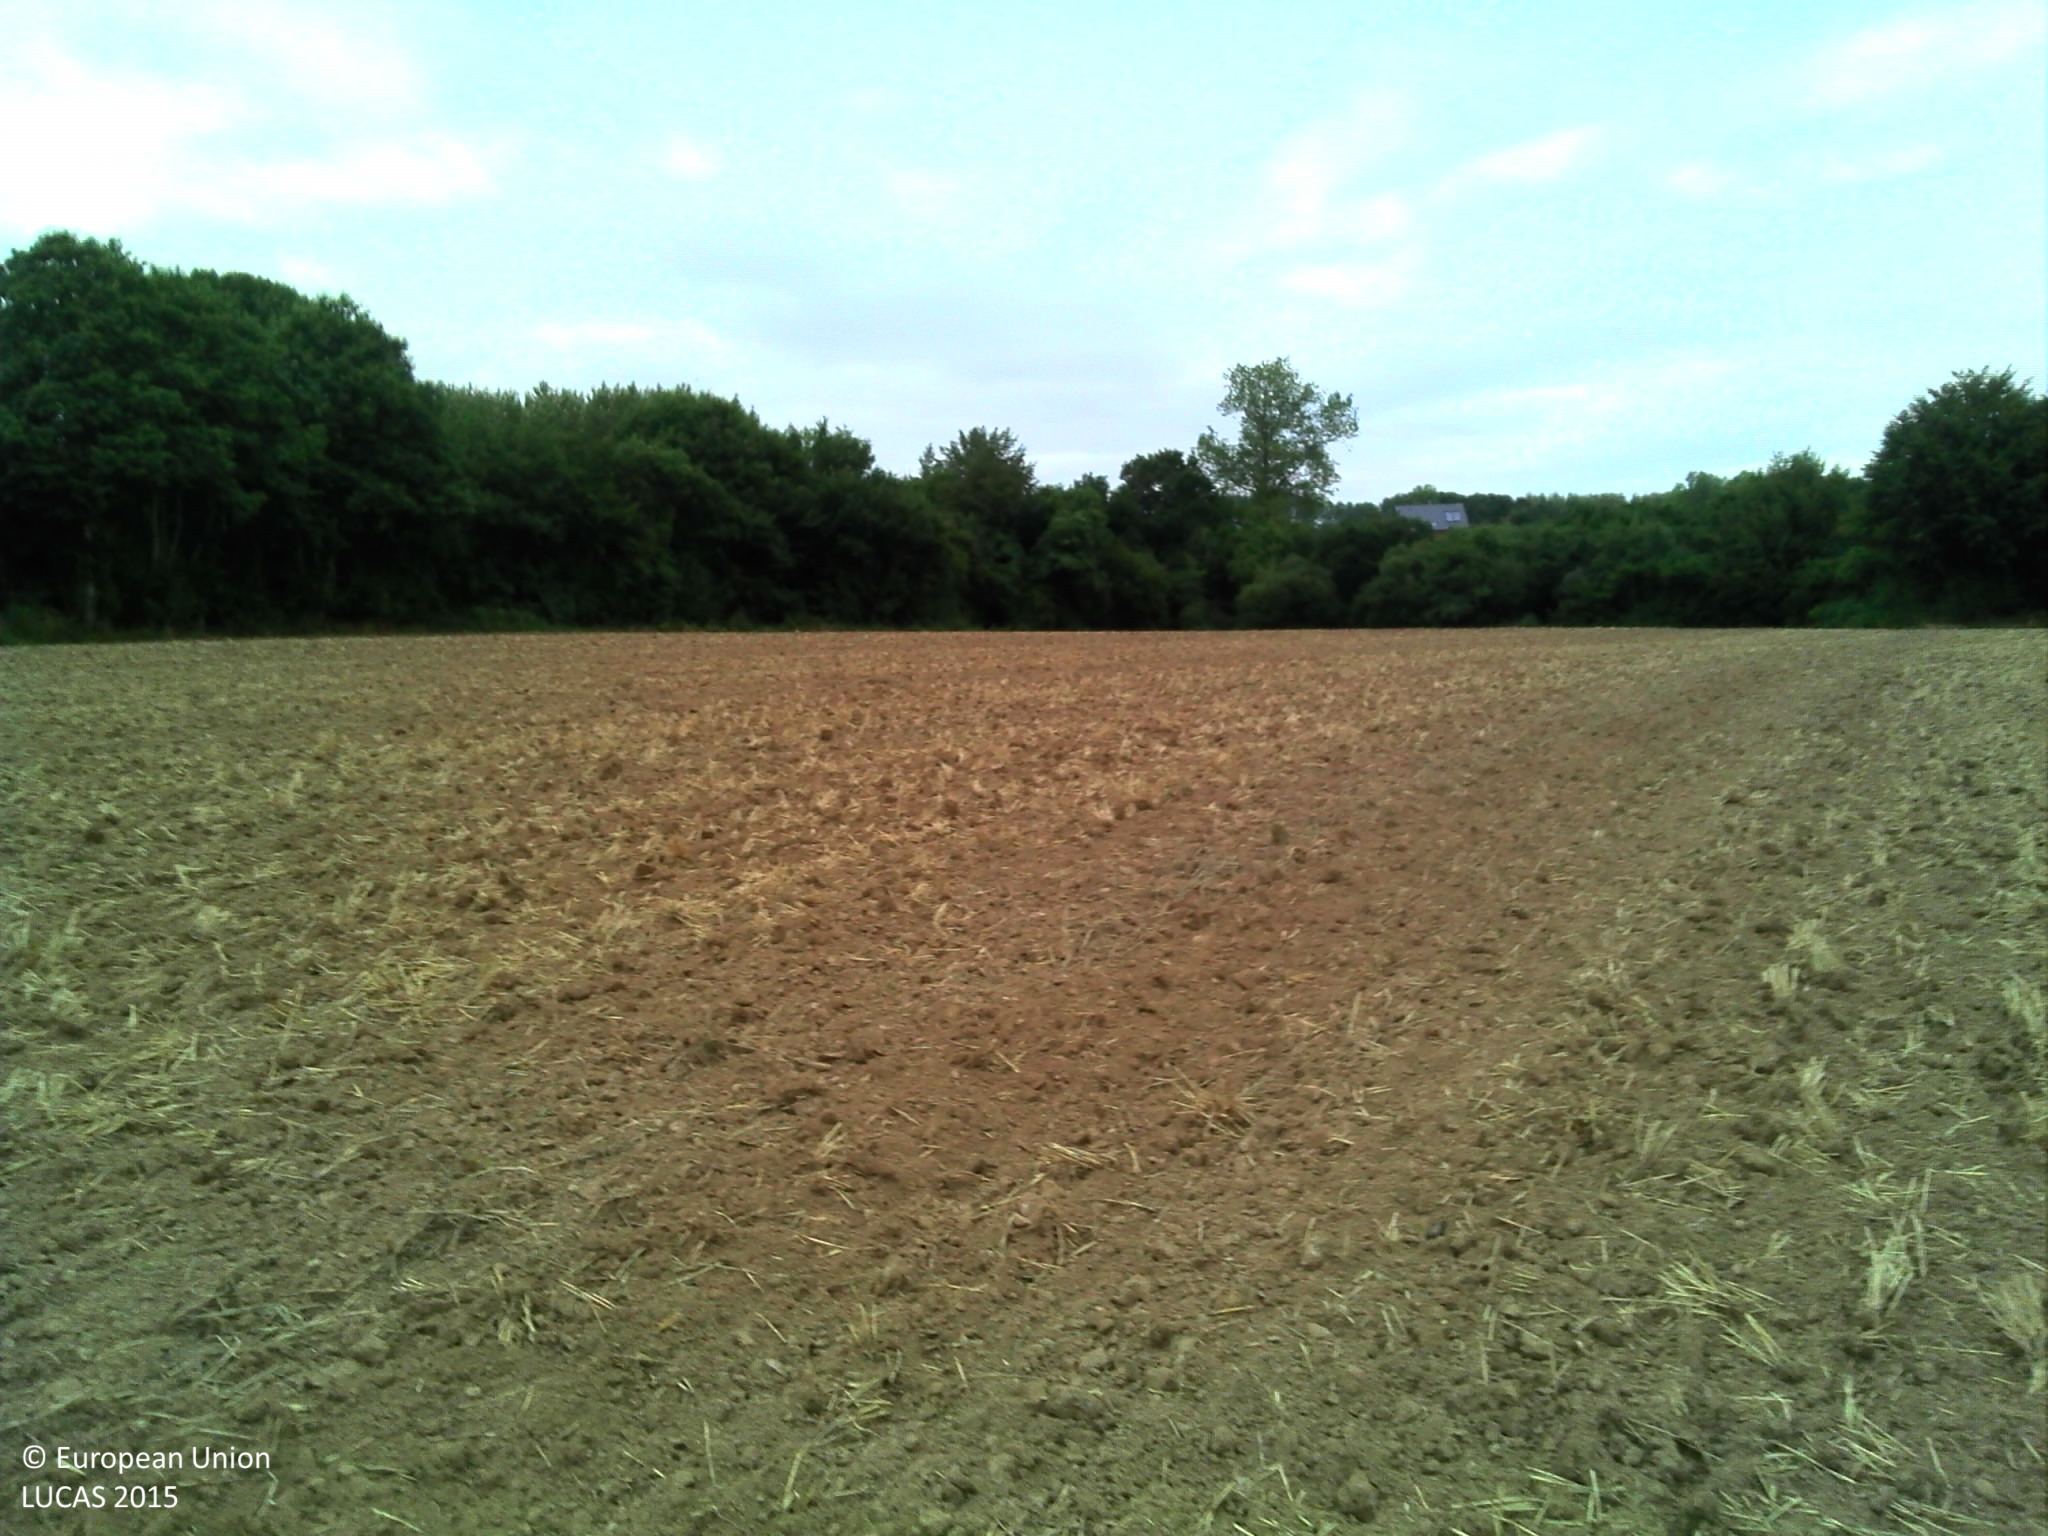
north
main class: Cropland
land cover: Common wheat
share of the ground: > 75 %
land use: Agriculture (excluding fallow land and kitchen gardens)
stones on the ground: < 10 %
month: August
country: FR
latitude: 48.6679
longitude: -3.1771
